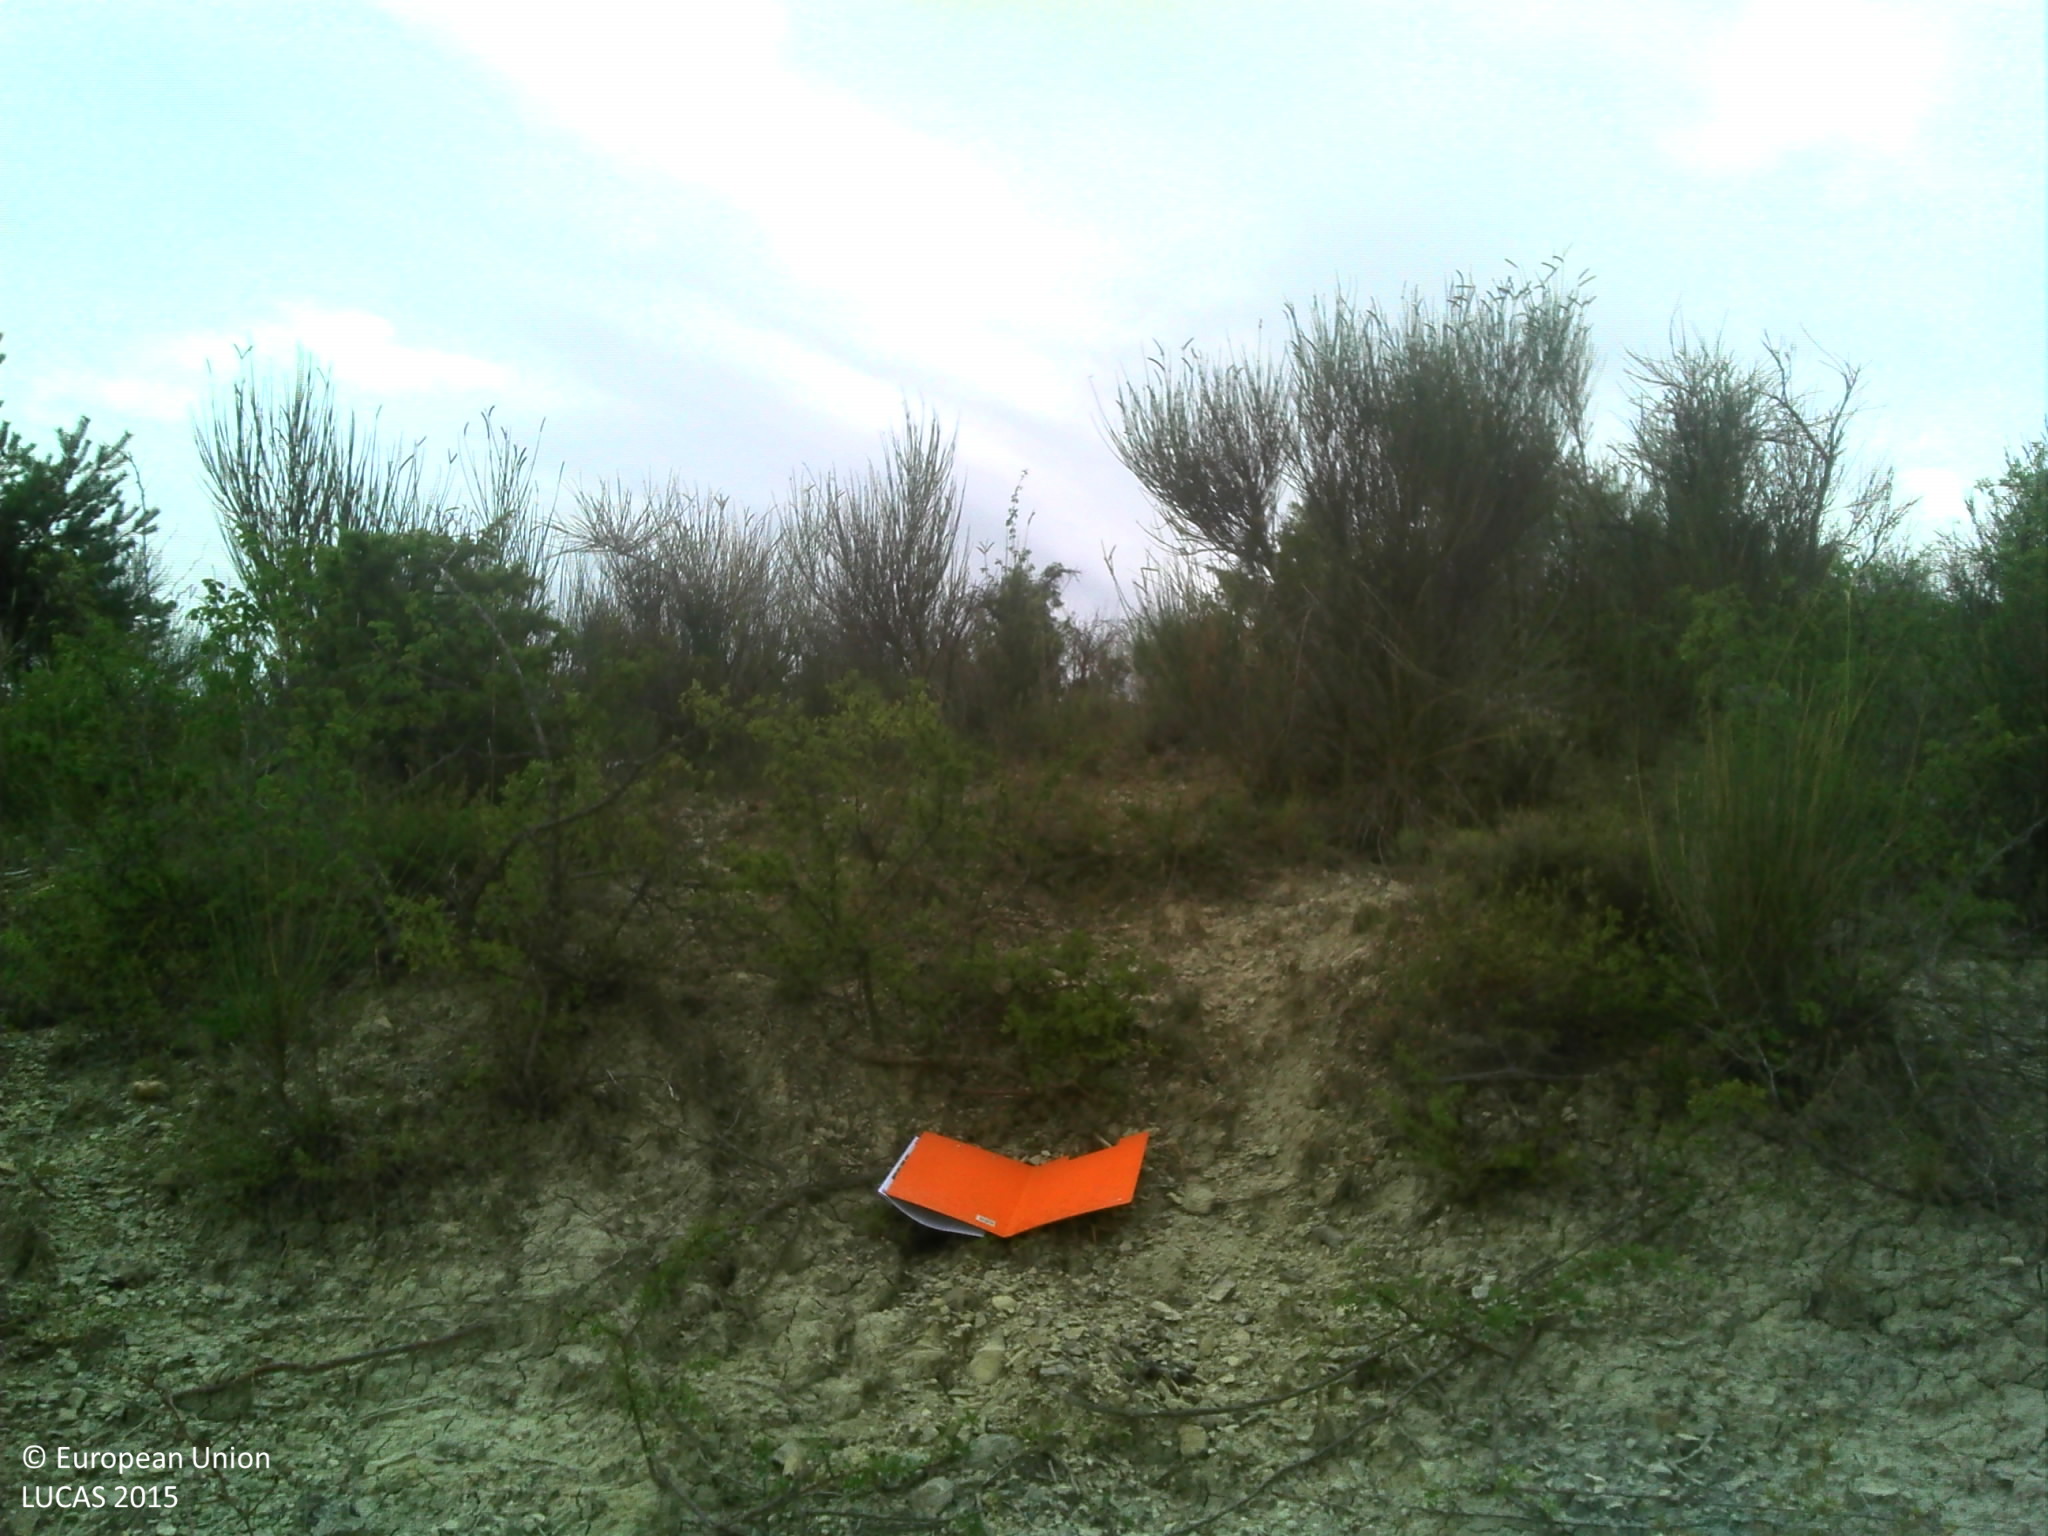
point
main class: Shrubland
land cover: Shrubland without tree cover
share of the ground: 50 - 75 %
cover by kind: shrubs 45 %, herbaceous plants 25 %, unconsolidated bare surface 20 %, consolidated bare surface 10 %
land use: Semi-natural and natural areas not in use
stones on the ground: > 50 %
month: July
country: FR
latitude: 43.9665
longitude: 5.5588
